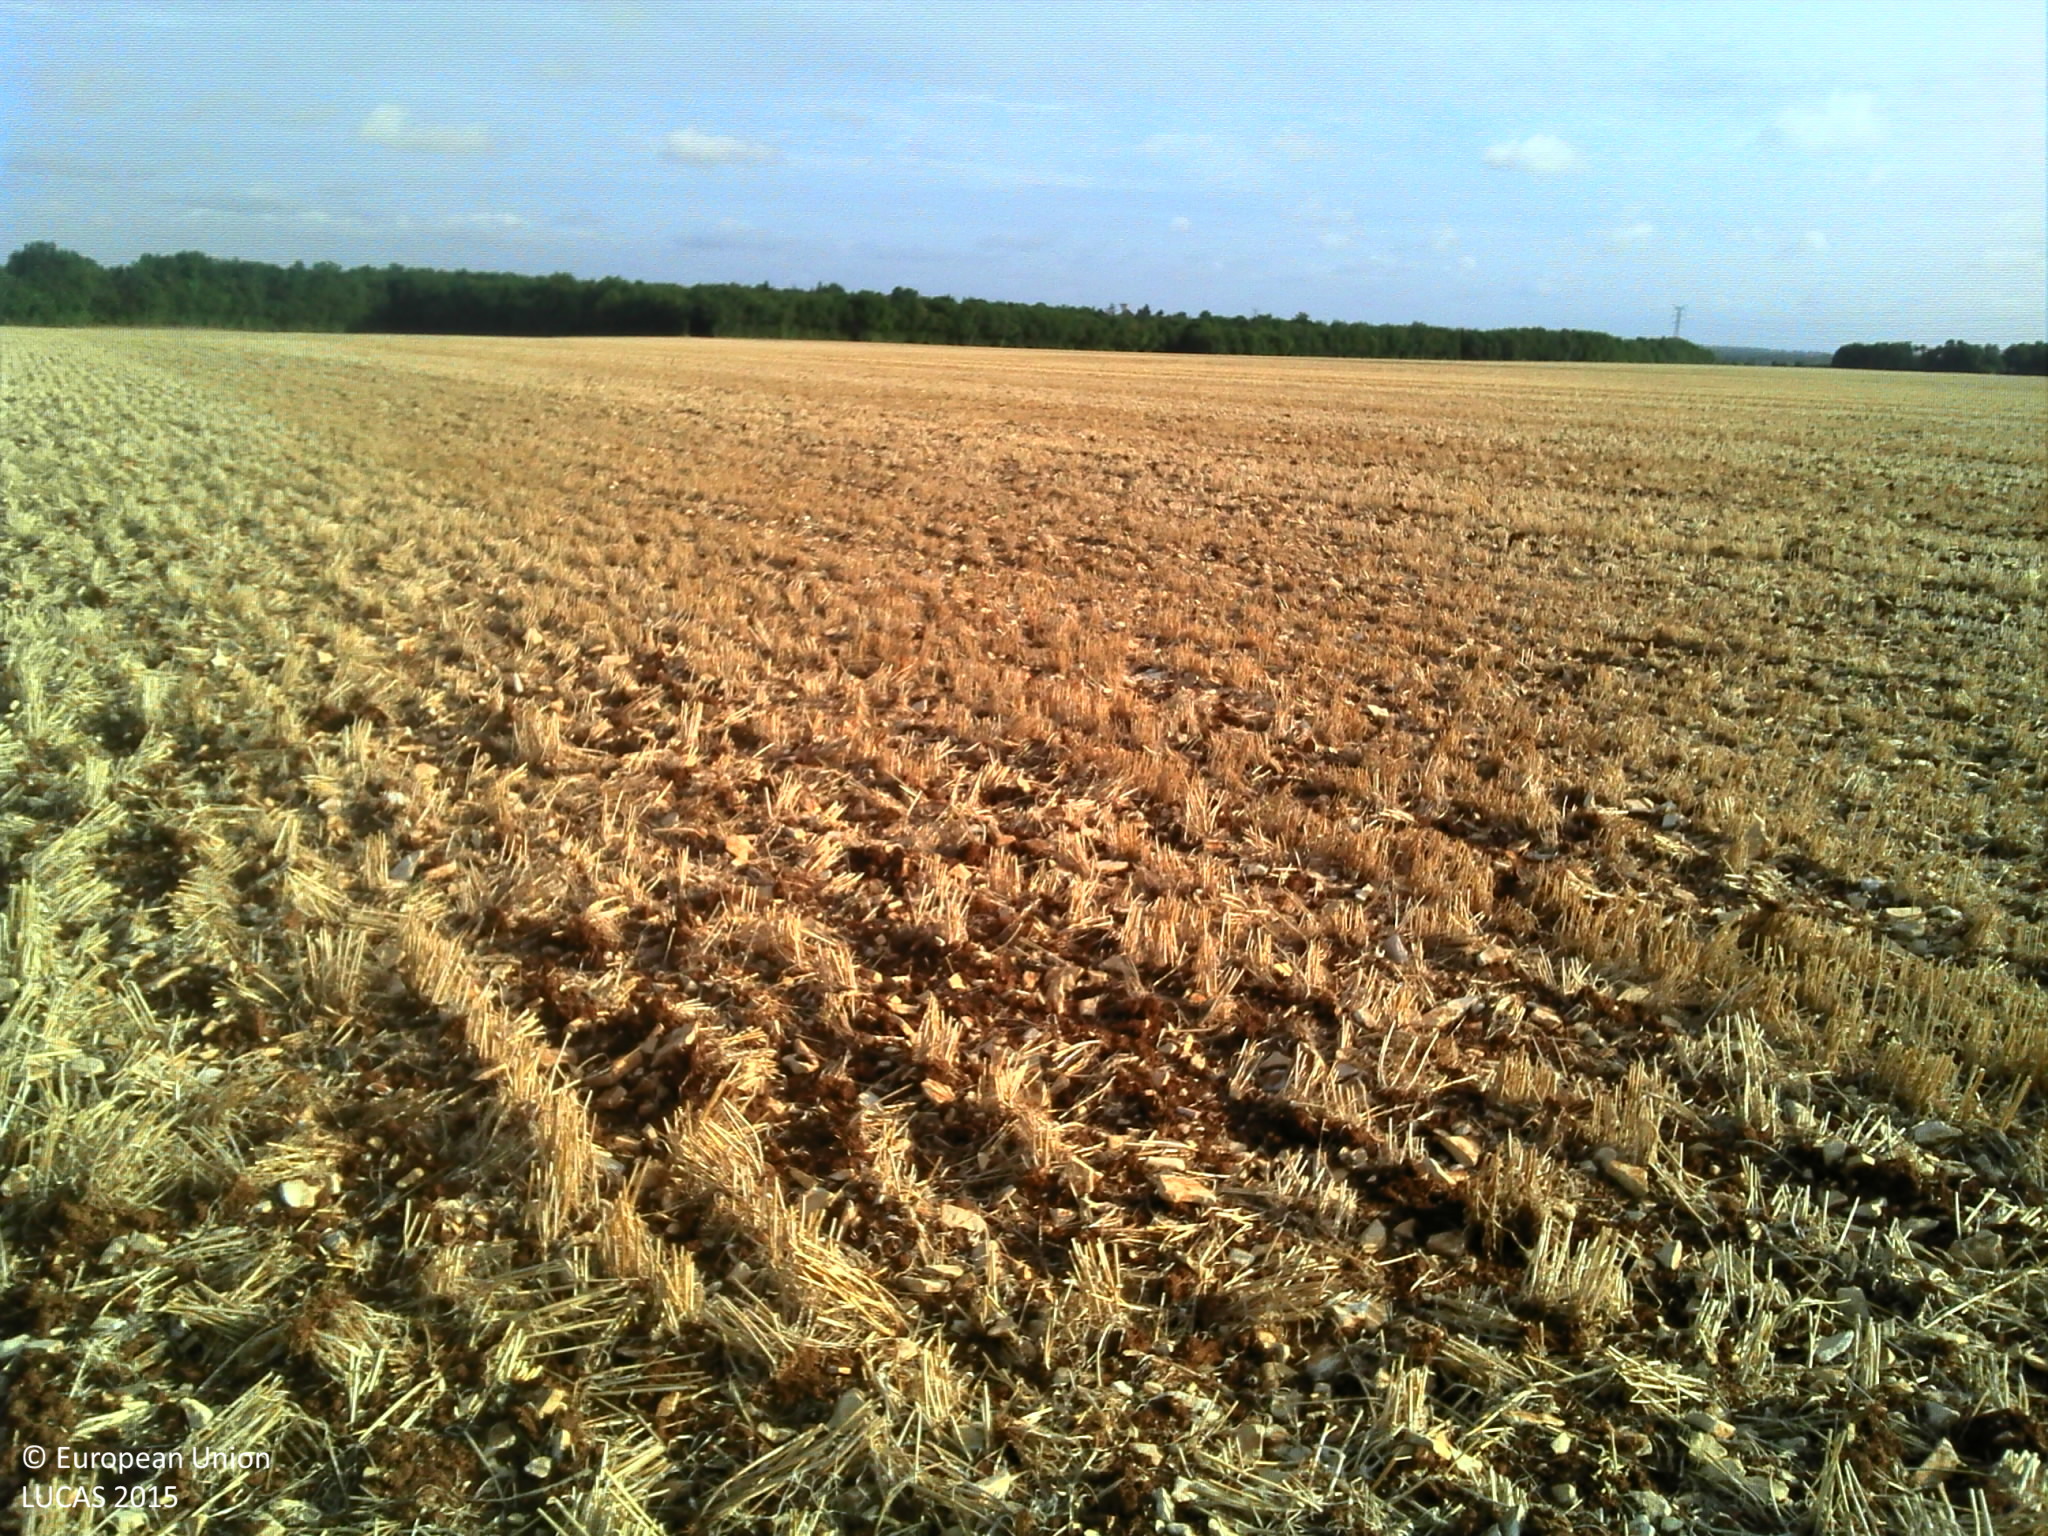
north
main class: Cropland
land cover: Barley
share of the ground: > 75 %
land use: Agriculture (excluding fallow land and kitchen gardens)
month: July
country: FR
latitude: 46.9205
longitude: 2.2579
